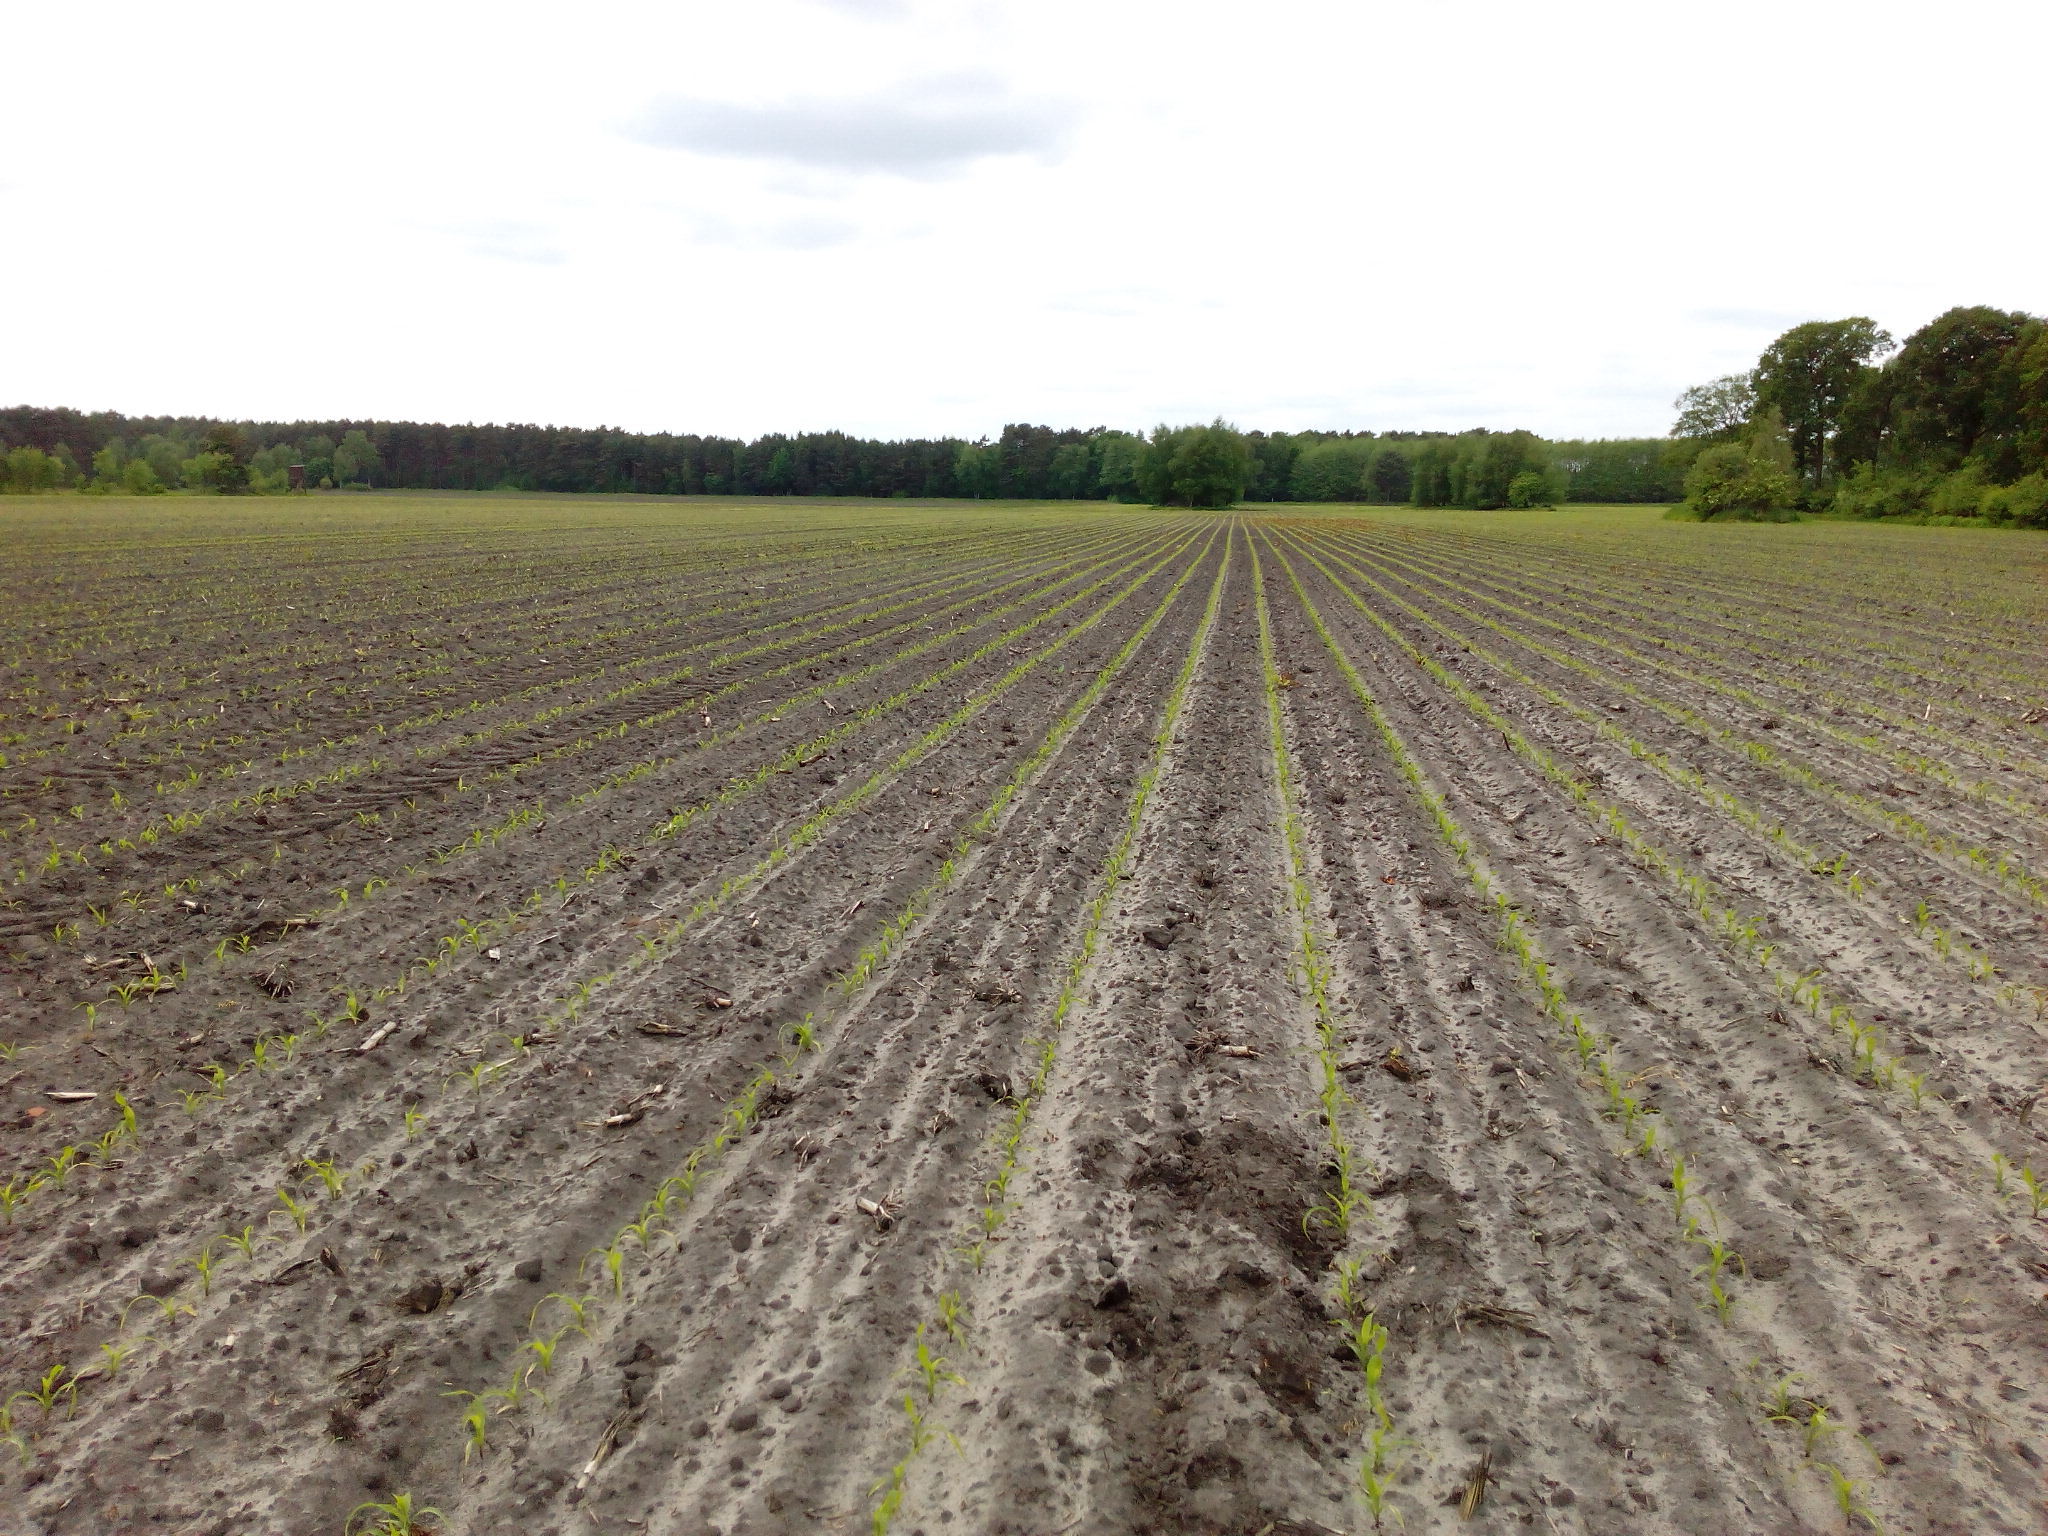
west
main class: Cropland
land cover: Maize
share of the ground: < 10 %
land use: Agriculture (excluding fallow land and kitchen gardens)
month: June
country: DE
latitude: 52.6470
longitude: 9.9261
